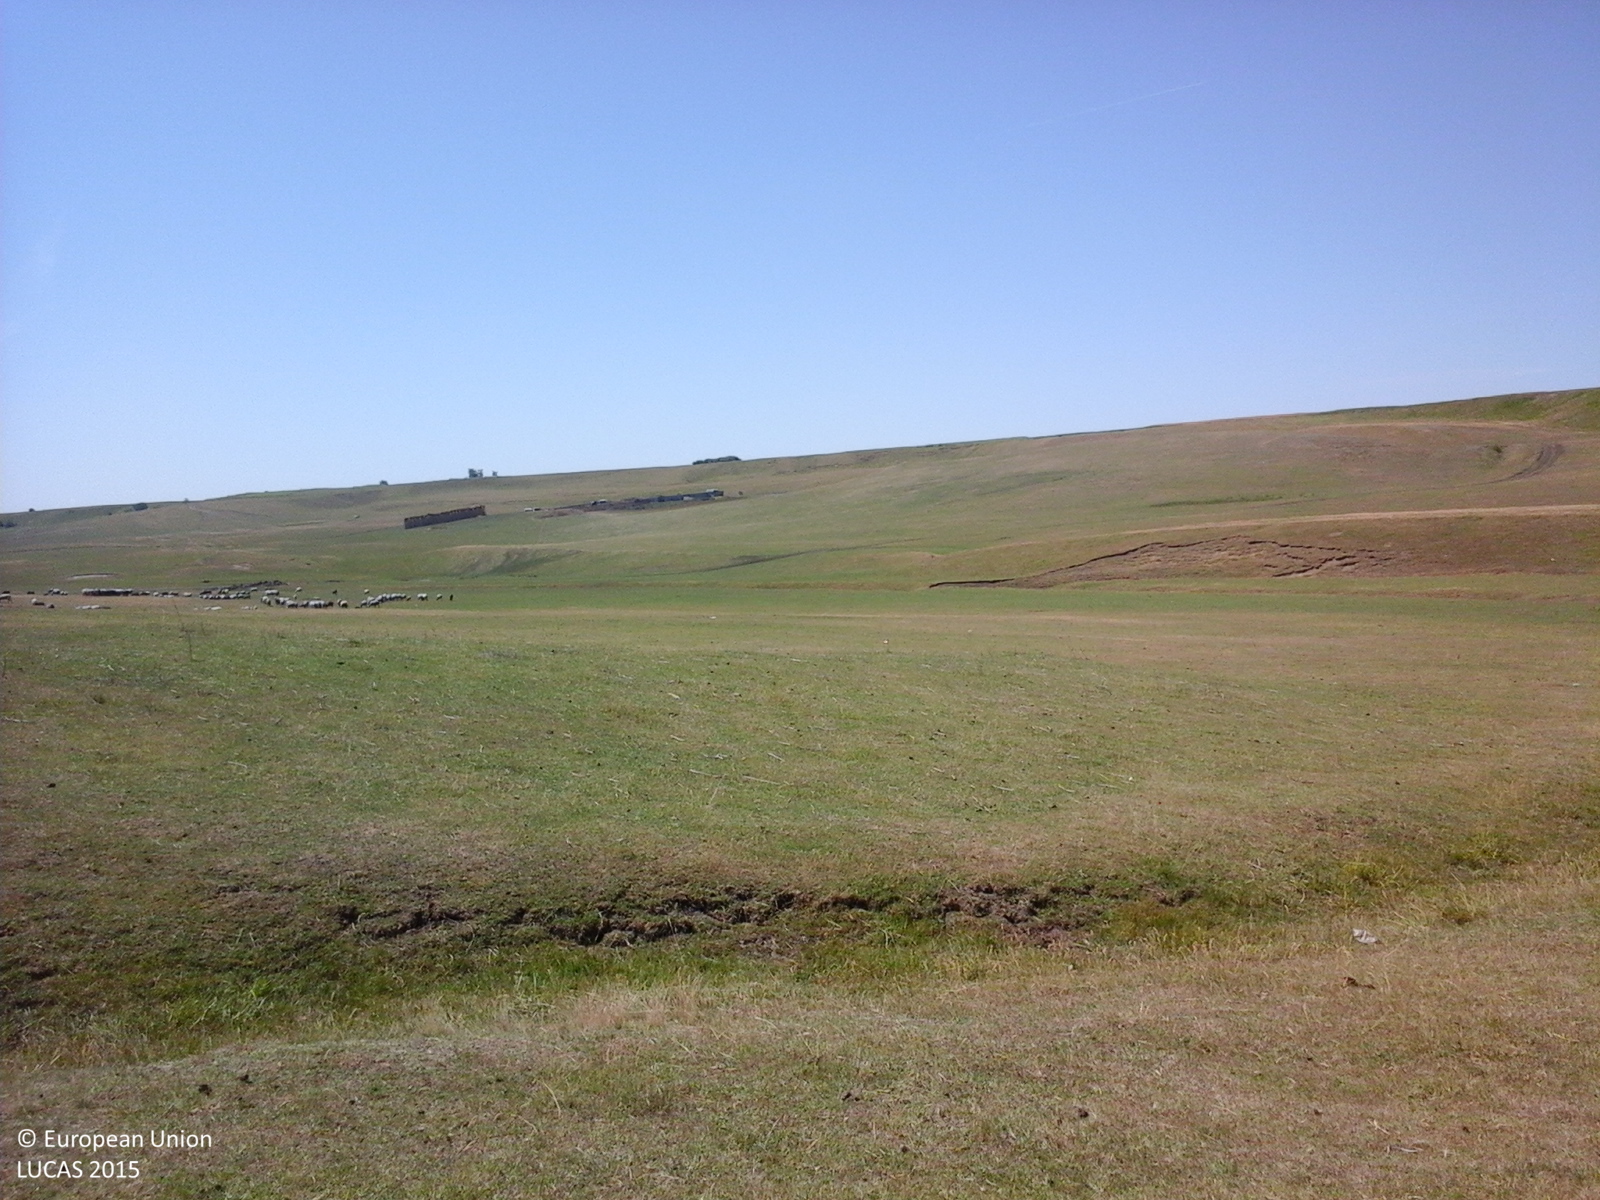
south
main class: Grassland
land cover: Grassland without tree/shrub cover
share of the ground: > 75 %
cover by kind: herbaceous plants 100 %
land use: Agriculture (excluding fallow land and kitchen gardens)
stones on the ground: 10 - 25 %
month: June
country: RO
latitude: 47.2440
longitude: 26.9713
